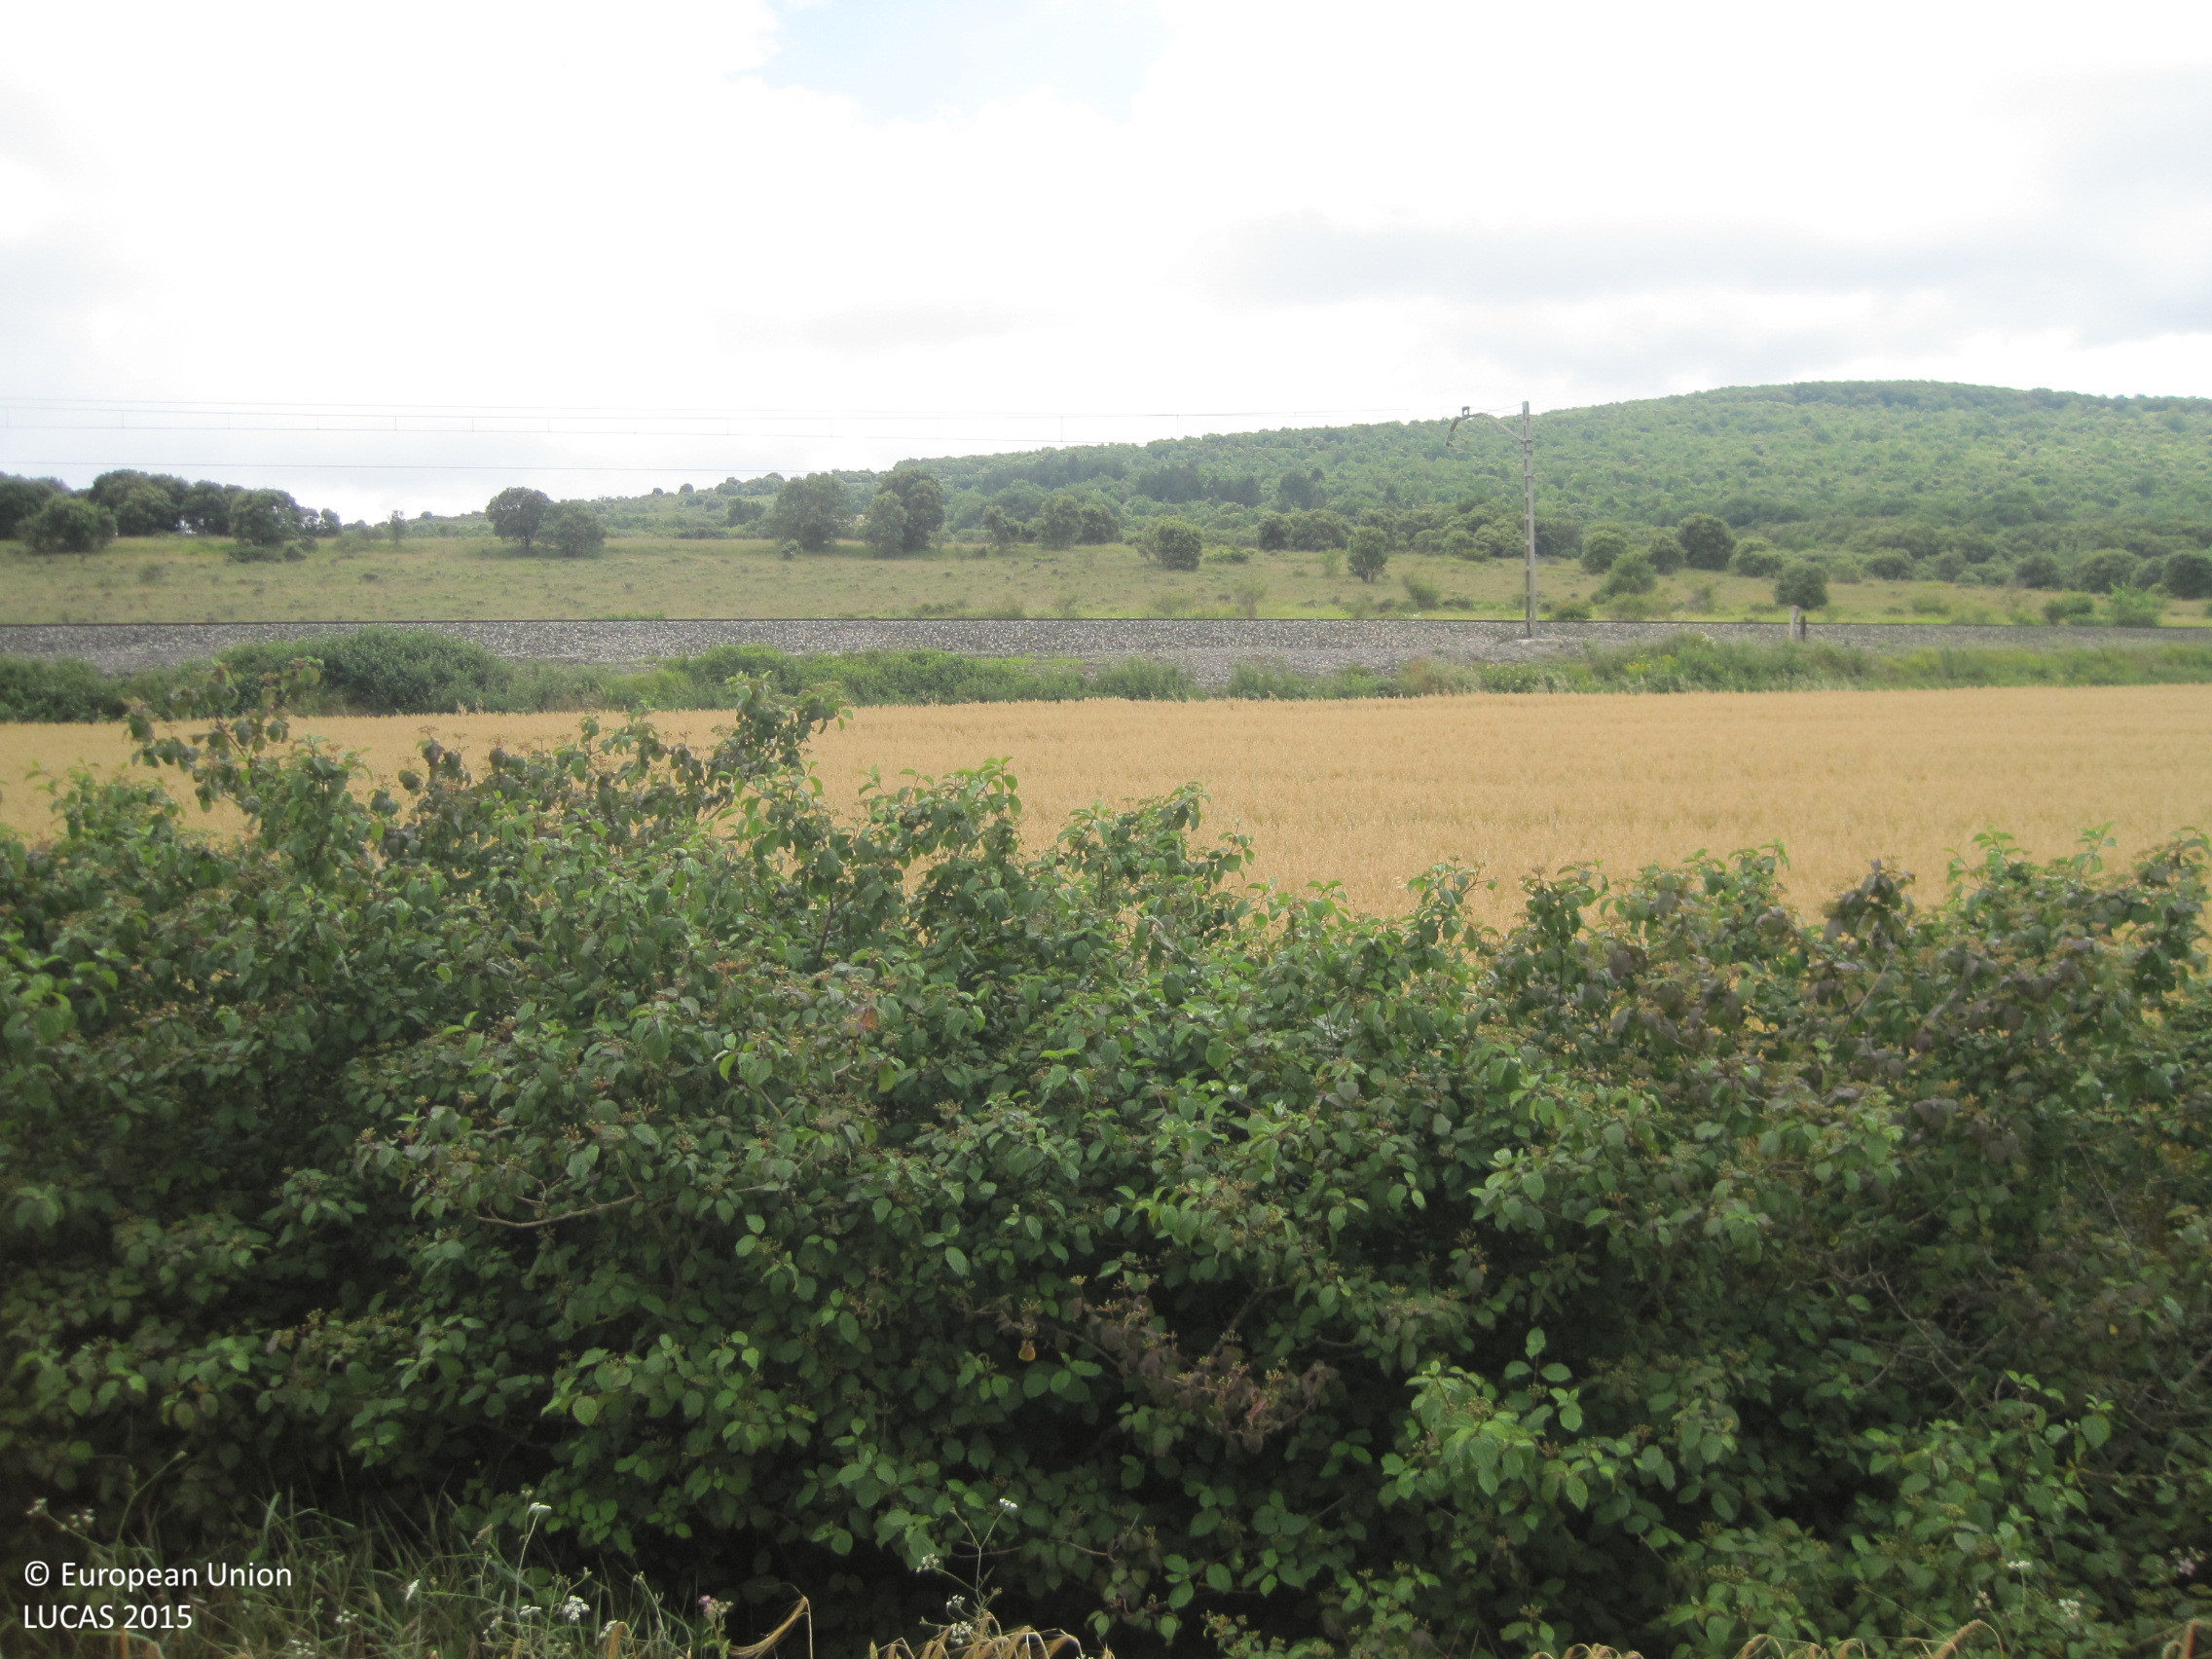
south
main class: Cropland
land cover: Barley
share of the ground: > 75 %
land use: Agriculture (excluding fallow land and kitchen gardens)
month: June
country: ES
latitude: 42.8753
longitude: -1.7811
